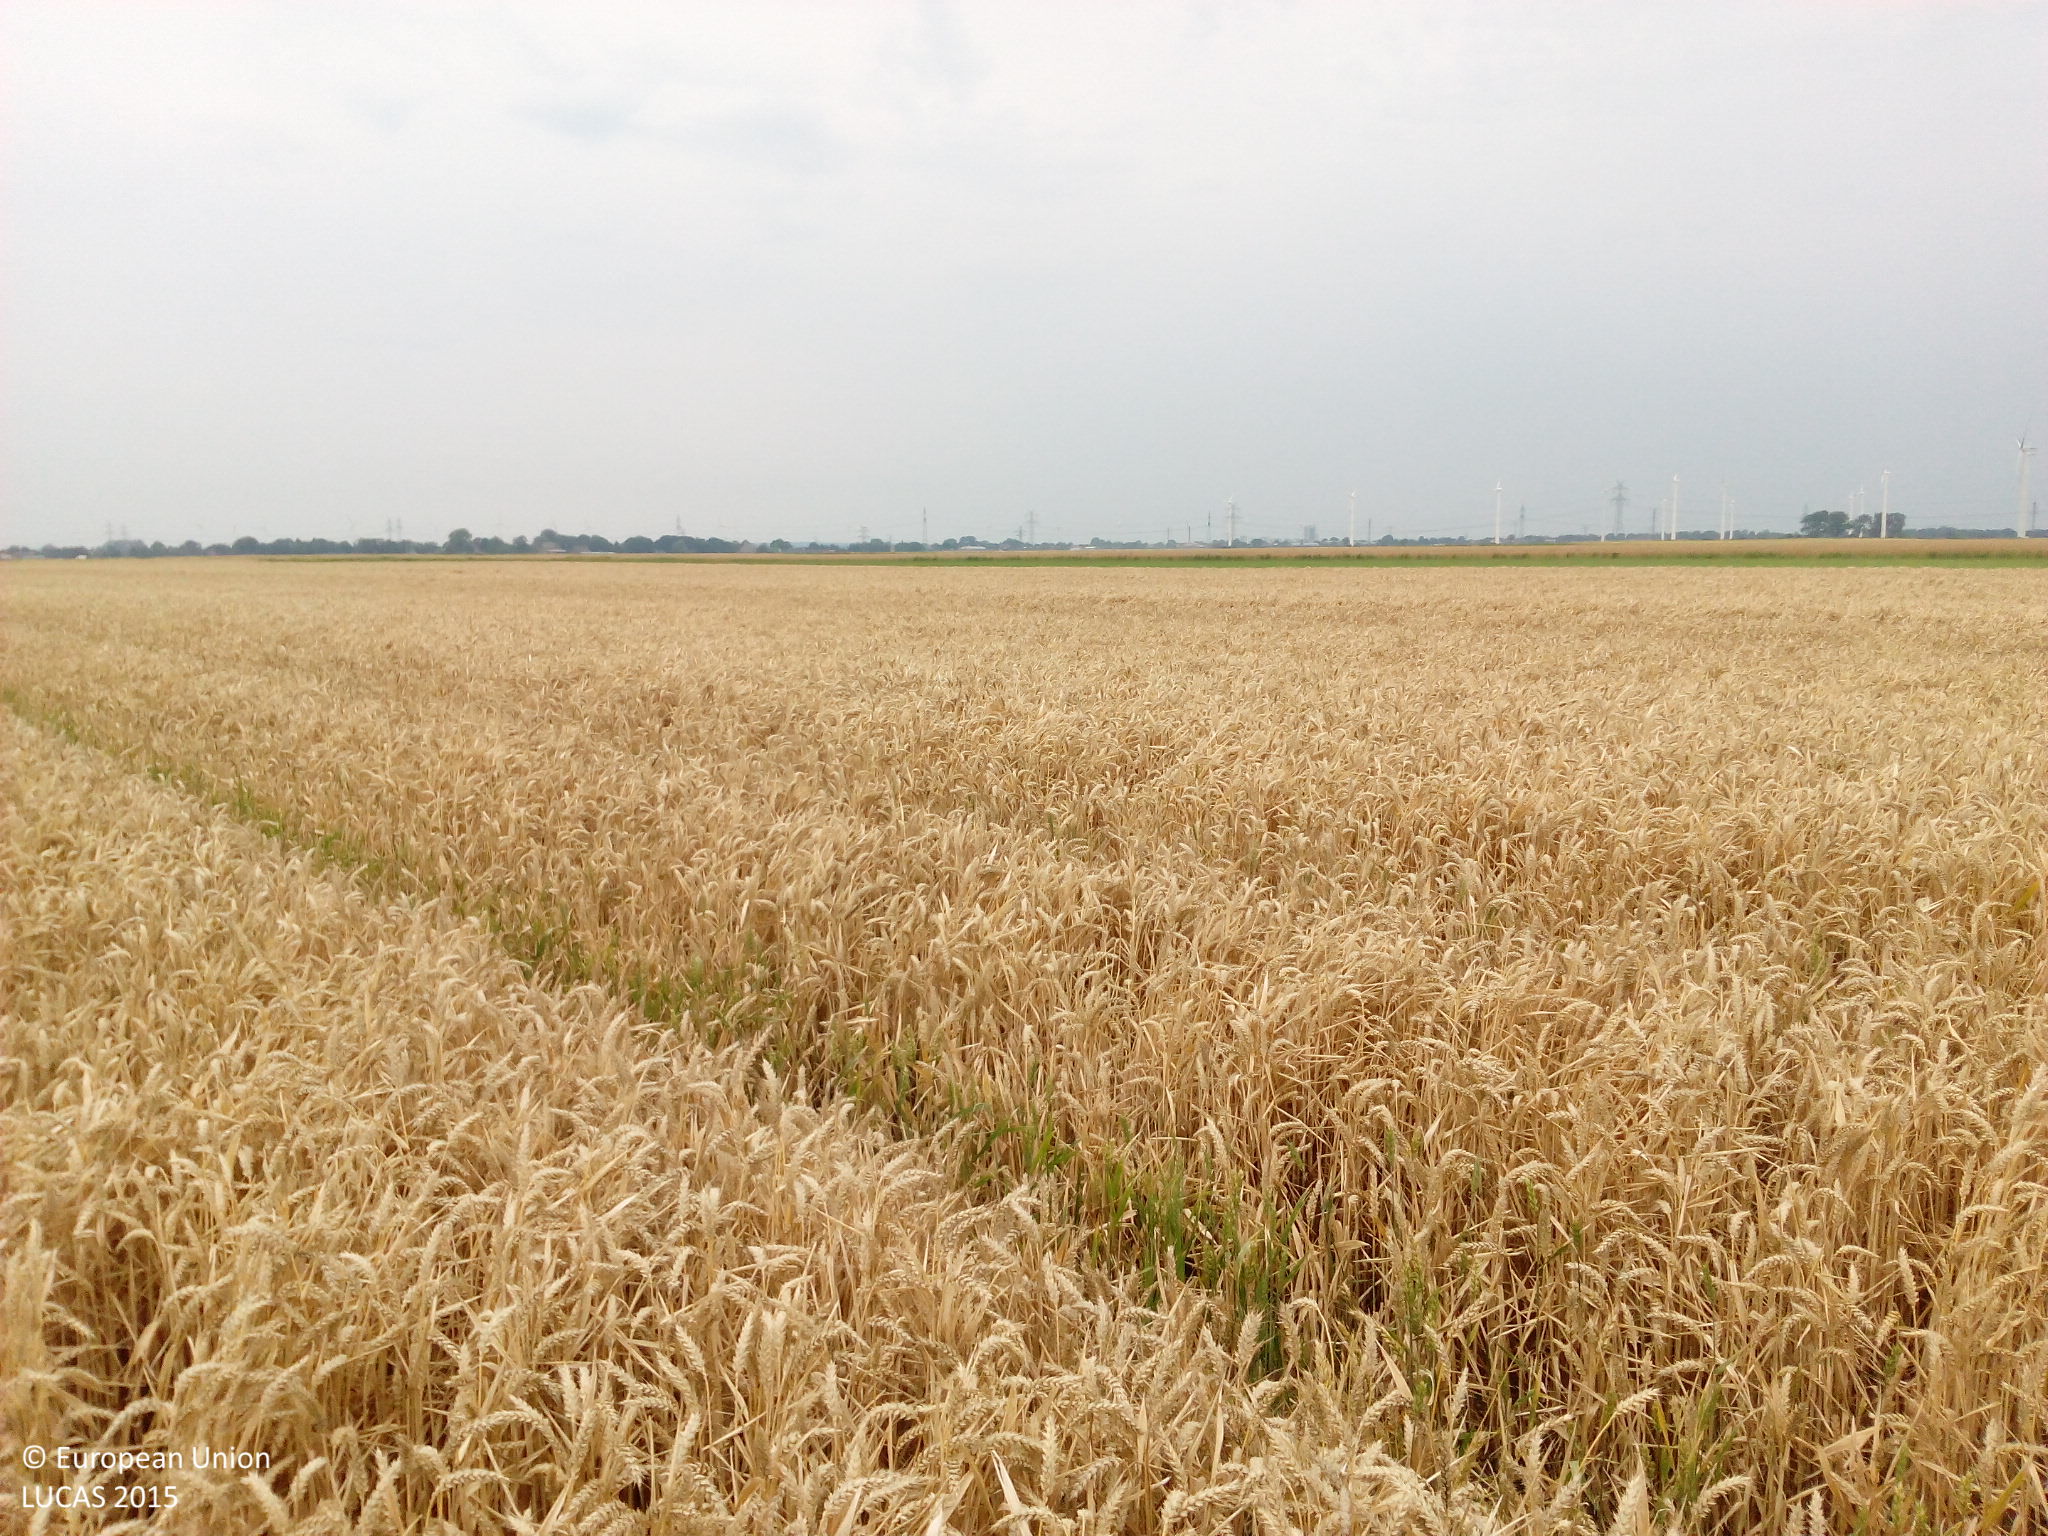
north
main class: Cropland
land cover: Common wheat
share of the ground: > 75 %
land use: Agriculture (excluding fallow land and kitchen gardens)
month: August
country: DE
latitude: 53.8145
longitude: 9.5598
